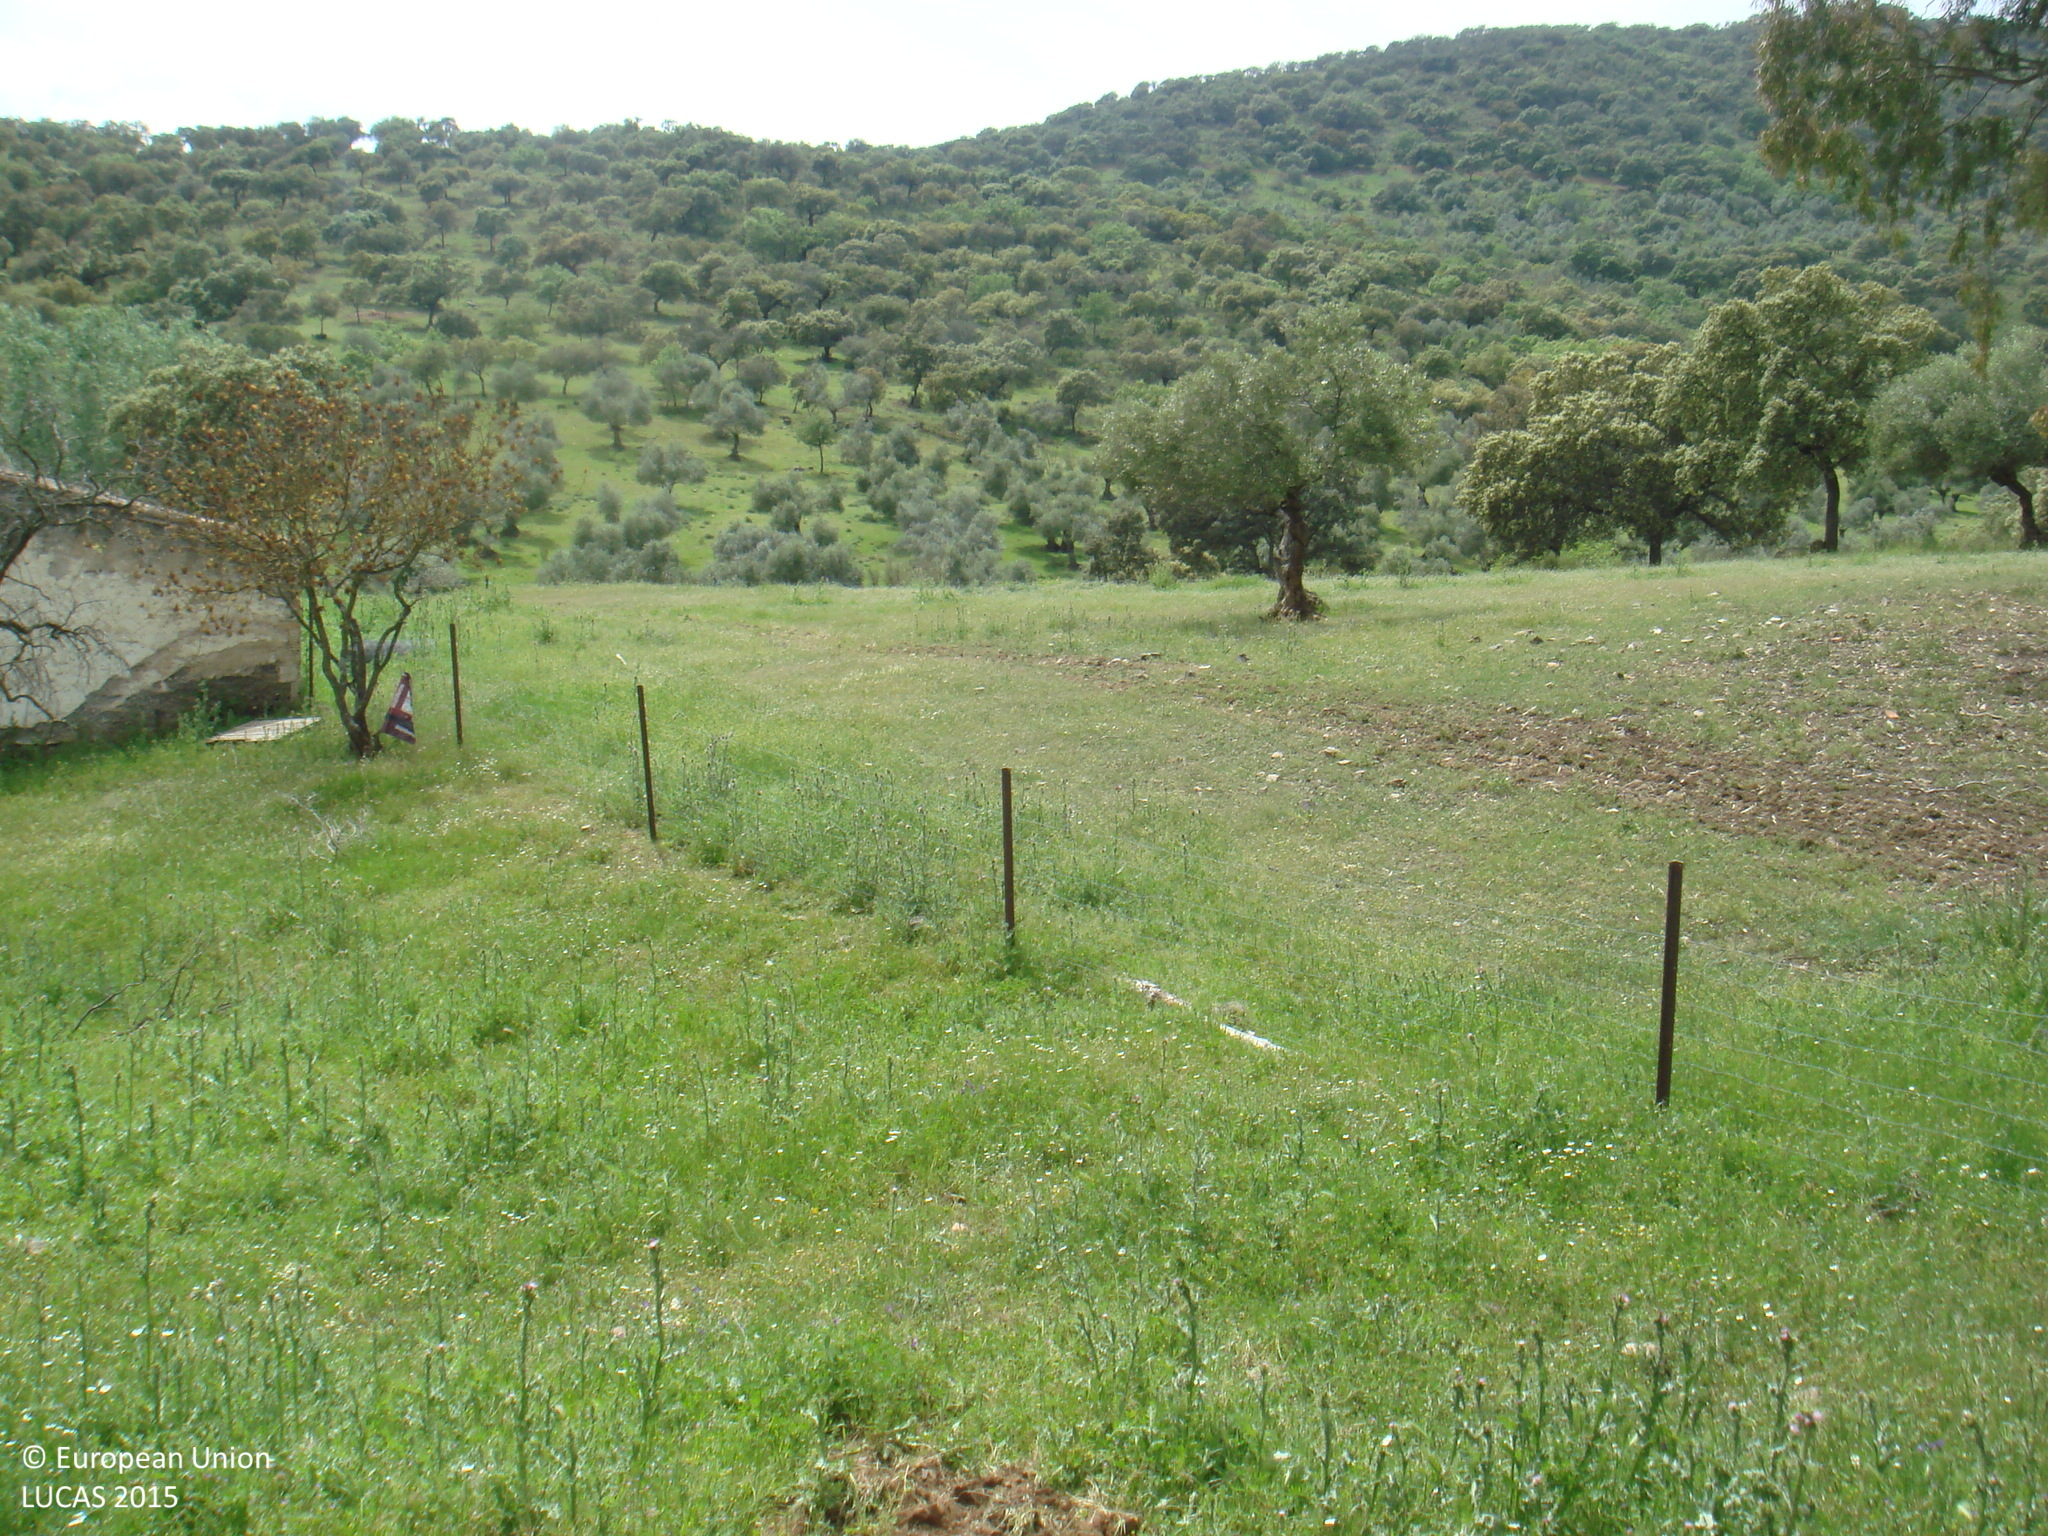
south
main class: Woodland
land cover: Broadleaved woodland
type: broadleaved evergreen forest
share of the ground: 25 - 50 %
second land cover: Grassland without tree/shrub cover
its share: 50 - 75 %
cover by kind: herbaceous plants 55 %, broadleaved forest trees 40 %, shrubs 5 %
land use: Forestry
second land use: Agriculture (excluding fallow land and kitchen gardens)
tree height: > 5 m
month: April
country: ES
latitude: 38.2497
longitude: -5.0738
